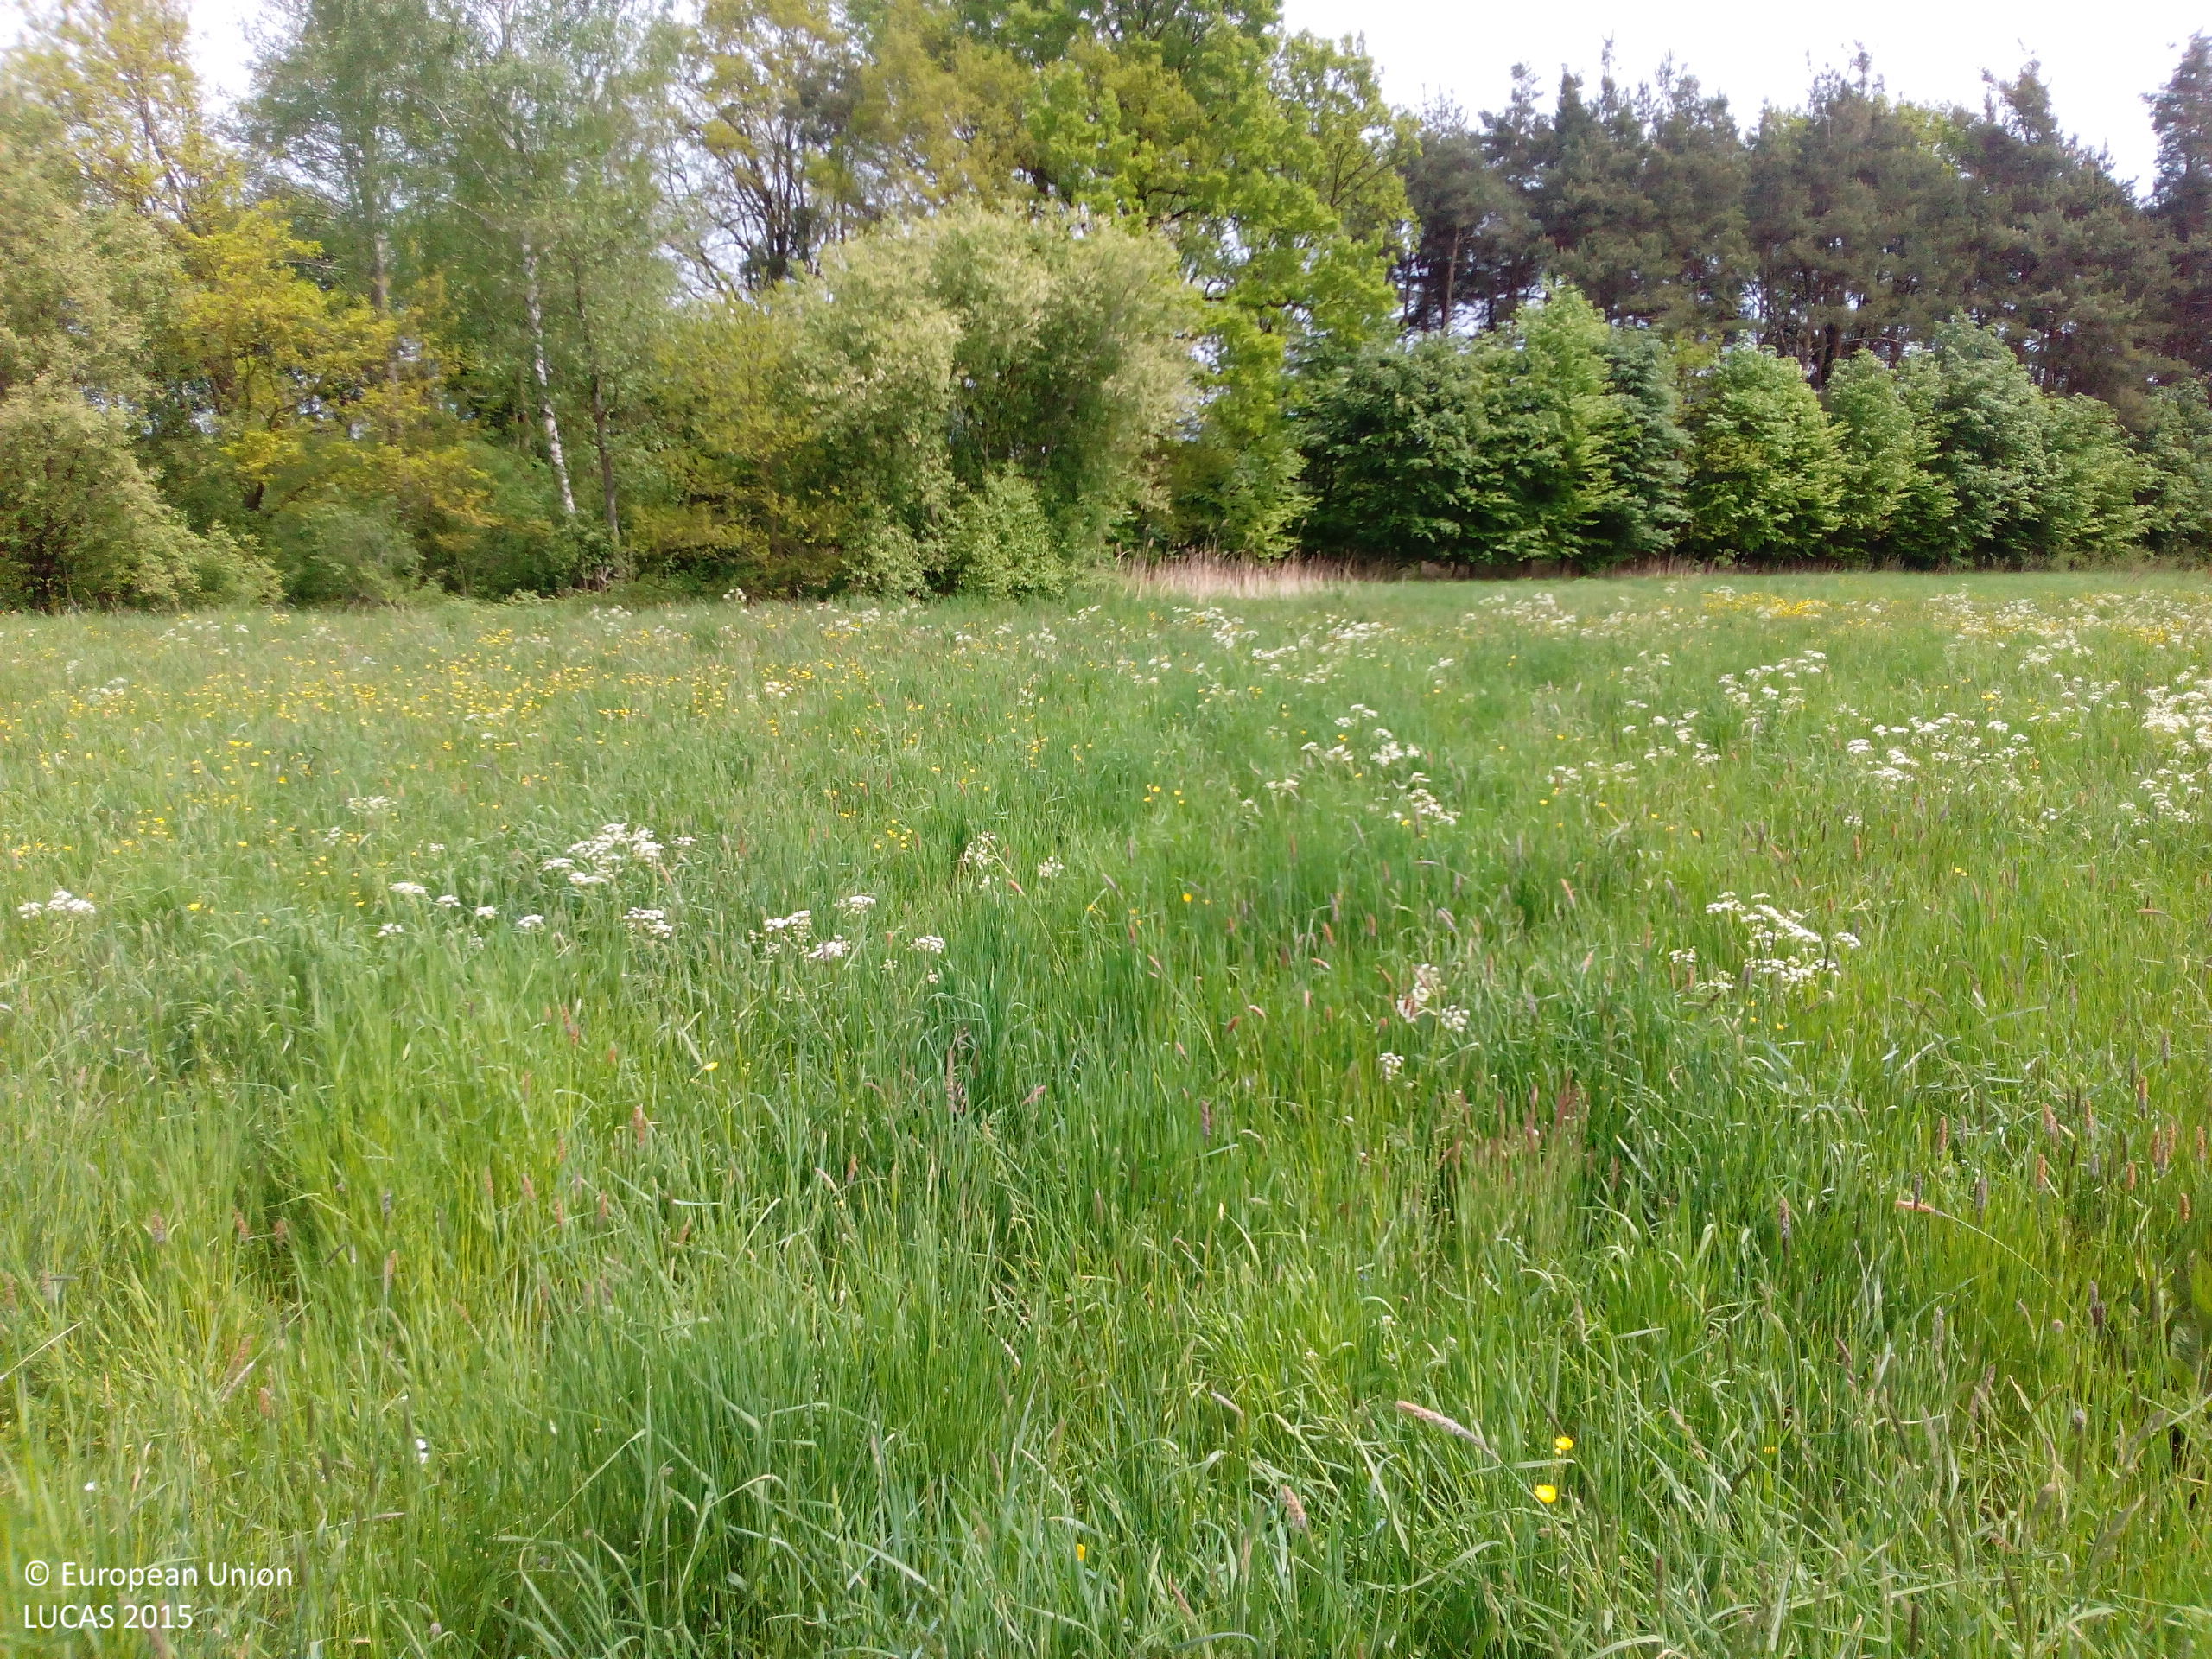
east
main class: Grassland
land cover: Grassland without tree/shrub cover
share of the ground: > 75 %
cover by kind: herbaceous plants 90 %, unconsolidated bare surface 10 %
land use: Agriculture (excluding fallow land and kitchen gardens)
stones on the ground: < 10 %
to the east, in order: Grassland without tree/shrub cover; Paved roads, cycling and walking lanes; Spontaneously vegetated surfaces; Broadleaved woodland; Lucerne; Electric lines; Lucerne
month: May
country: DE
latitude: 49.2578
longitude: 11.4422
